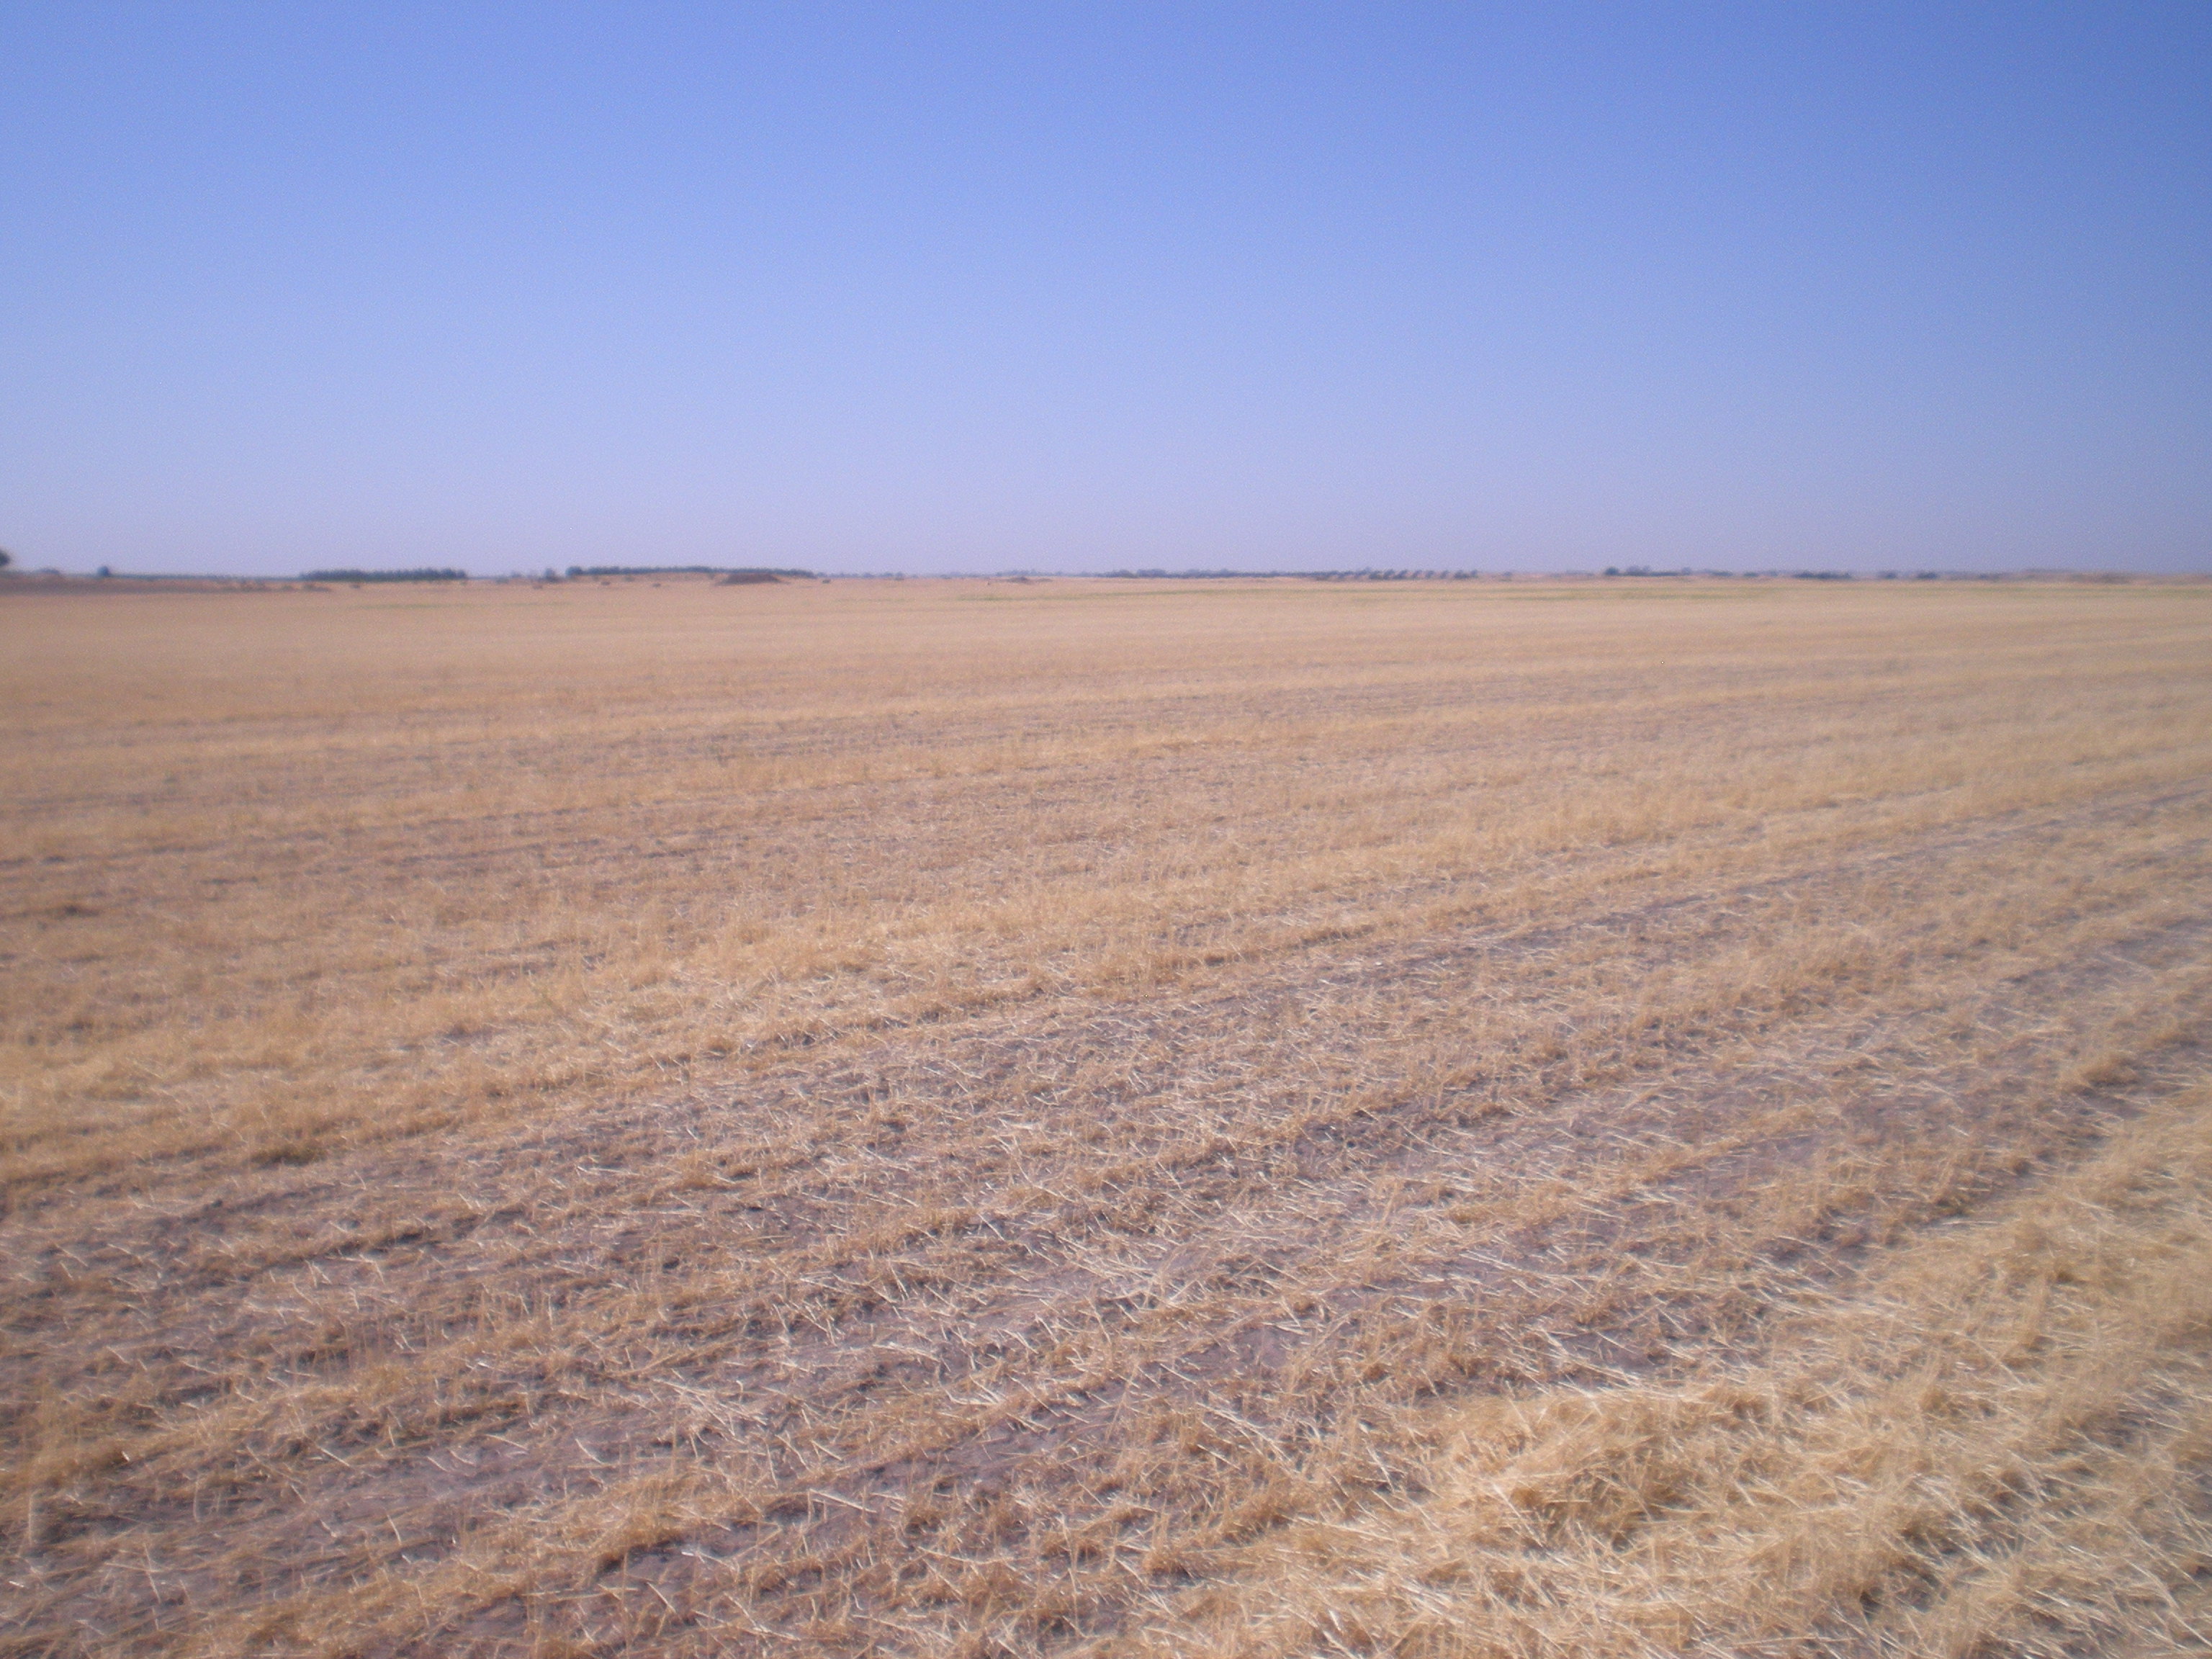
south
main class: Cropland
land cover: Barley
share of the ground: < 10 %
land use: Agriculture (excluding fallow land and kitchen gardens)
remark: Harvested field
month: July
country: ES
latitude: 39.3272
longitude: -3.2534
